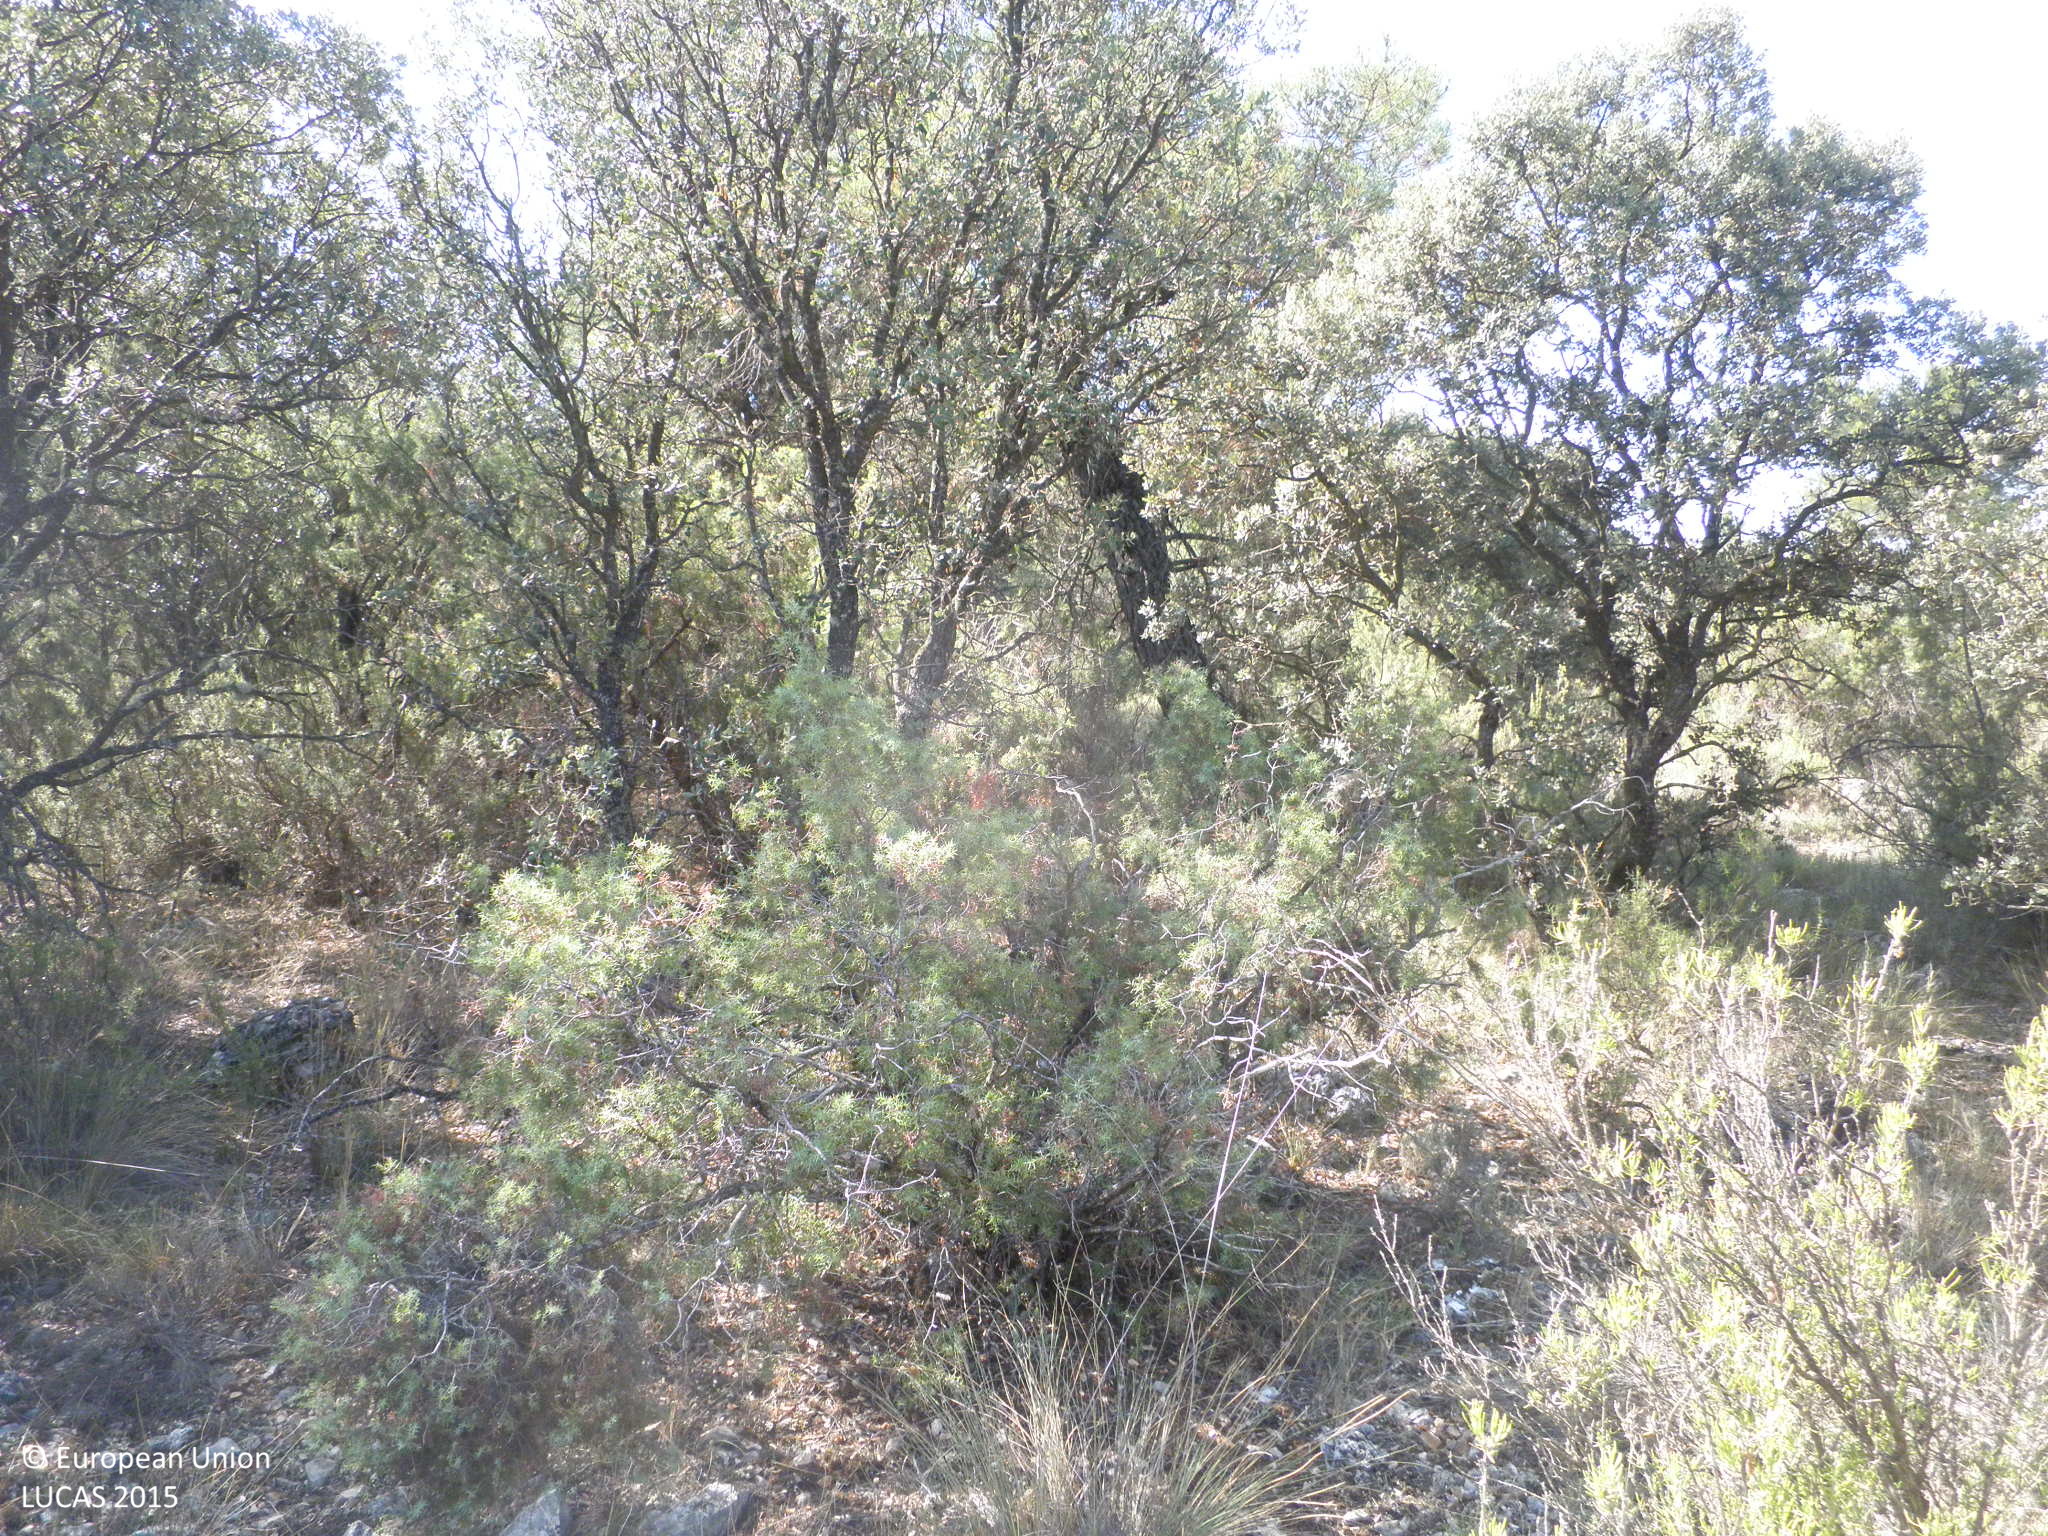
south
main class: Woodland
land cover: Pine dominated mixed woodland
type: coniferous forest of the mediterranean region
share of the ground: 25 - 50 %
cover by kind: coniferous forest trees 25 %, unconsolidated bare surface 25 %, broadleaved forest trees 20 %, shrubs 15 %, herbaceous plants 15 %
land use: Semi-natural and natural areas not in use
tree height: > 5 m
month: July
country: ES
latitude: 39.6302
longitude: -1.7630
